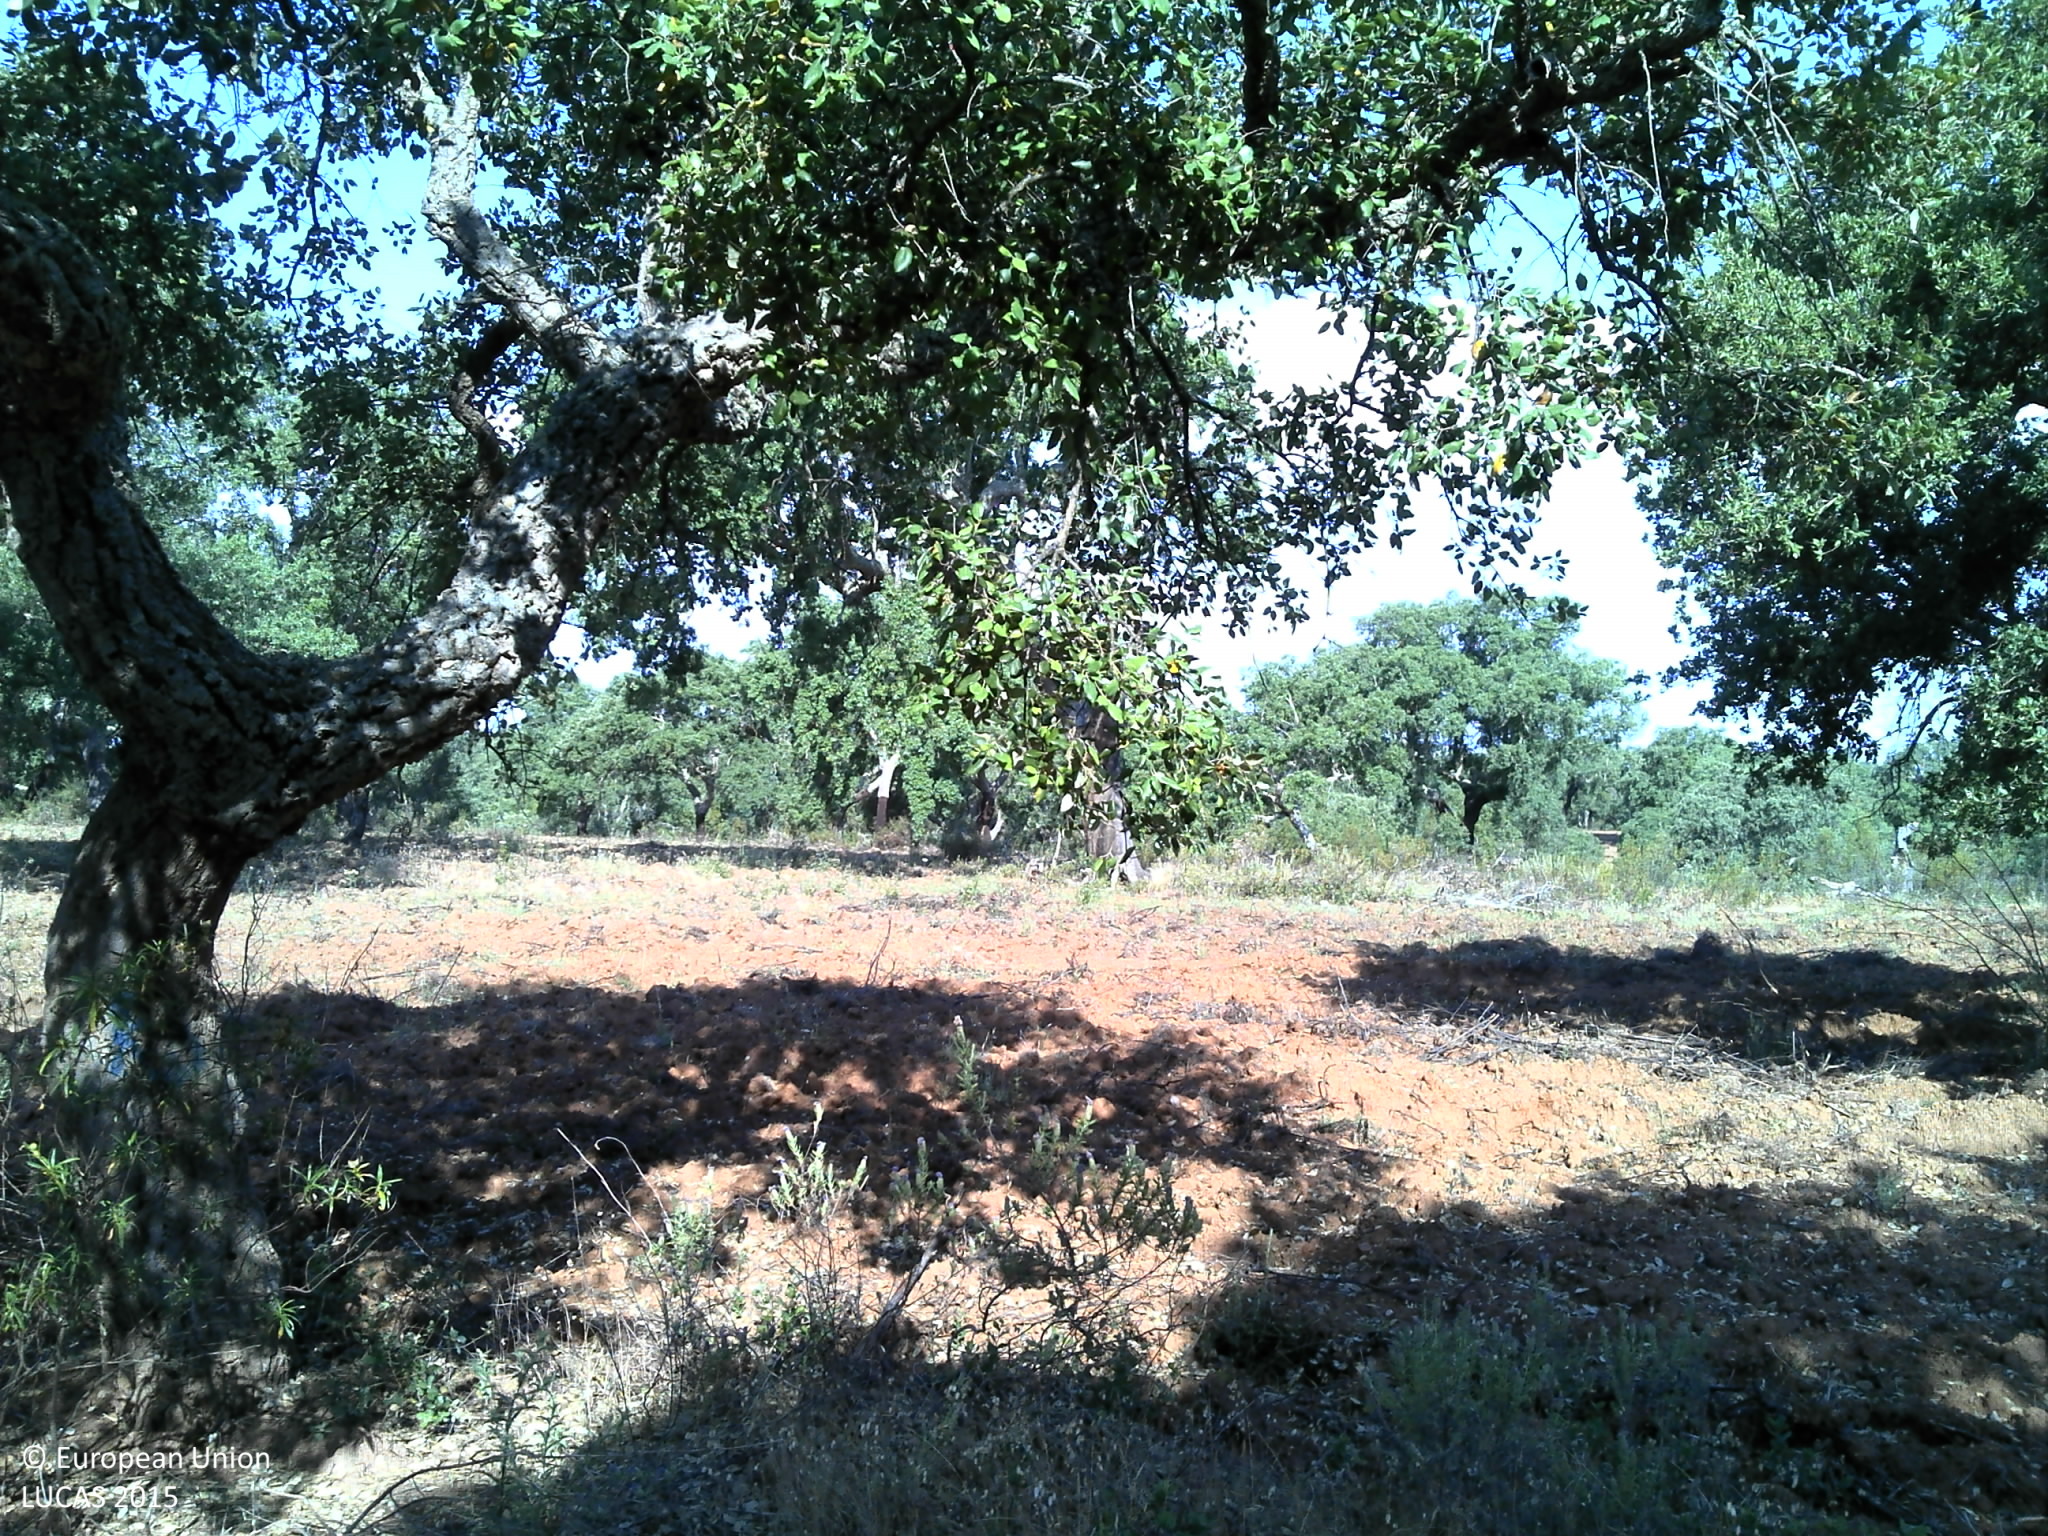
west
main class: Woodland
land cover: Broadleaved woodland
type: broadleaved evergreen forest
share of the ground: 50 - 75 %
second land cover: Spontaneously vegetated surfaces
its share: 10 - 25 %
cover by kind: broadleaved forest trees 60 %, unconsolidated bare surface 25 %, herbaceous plants 15 %
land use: Forestry
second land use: Agriculture (excluding fallow land and kitchen gardens)
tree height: > 5 m
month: May
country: PT
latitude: 38.8863
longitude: -7.7845
